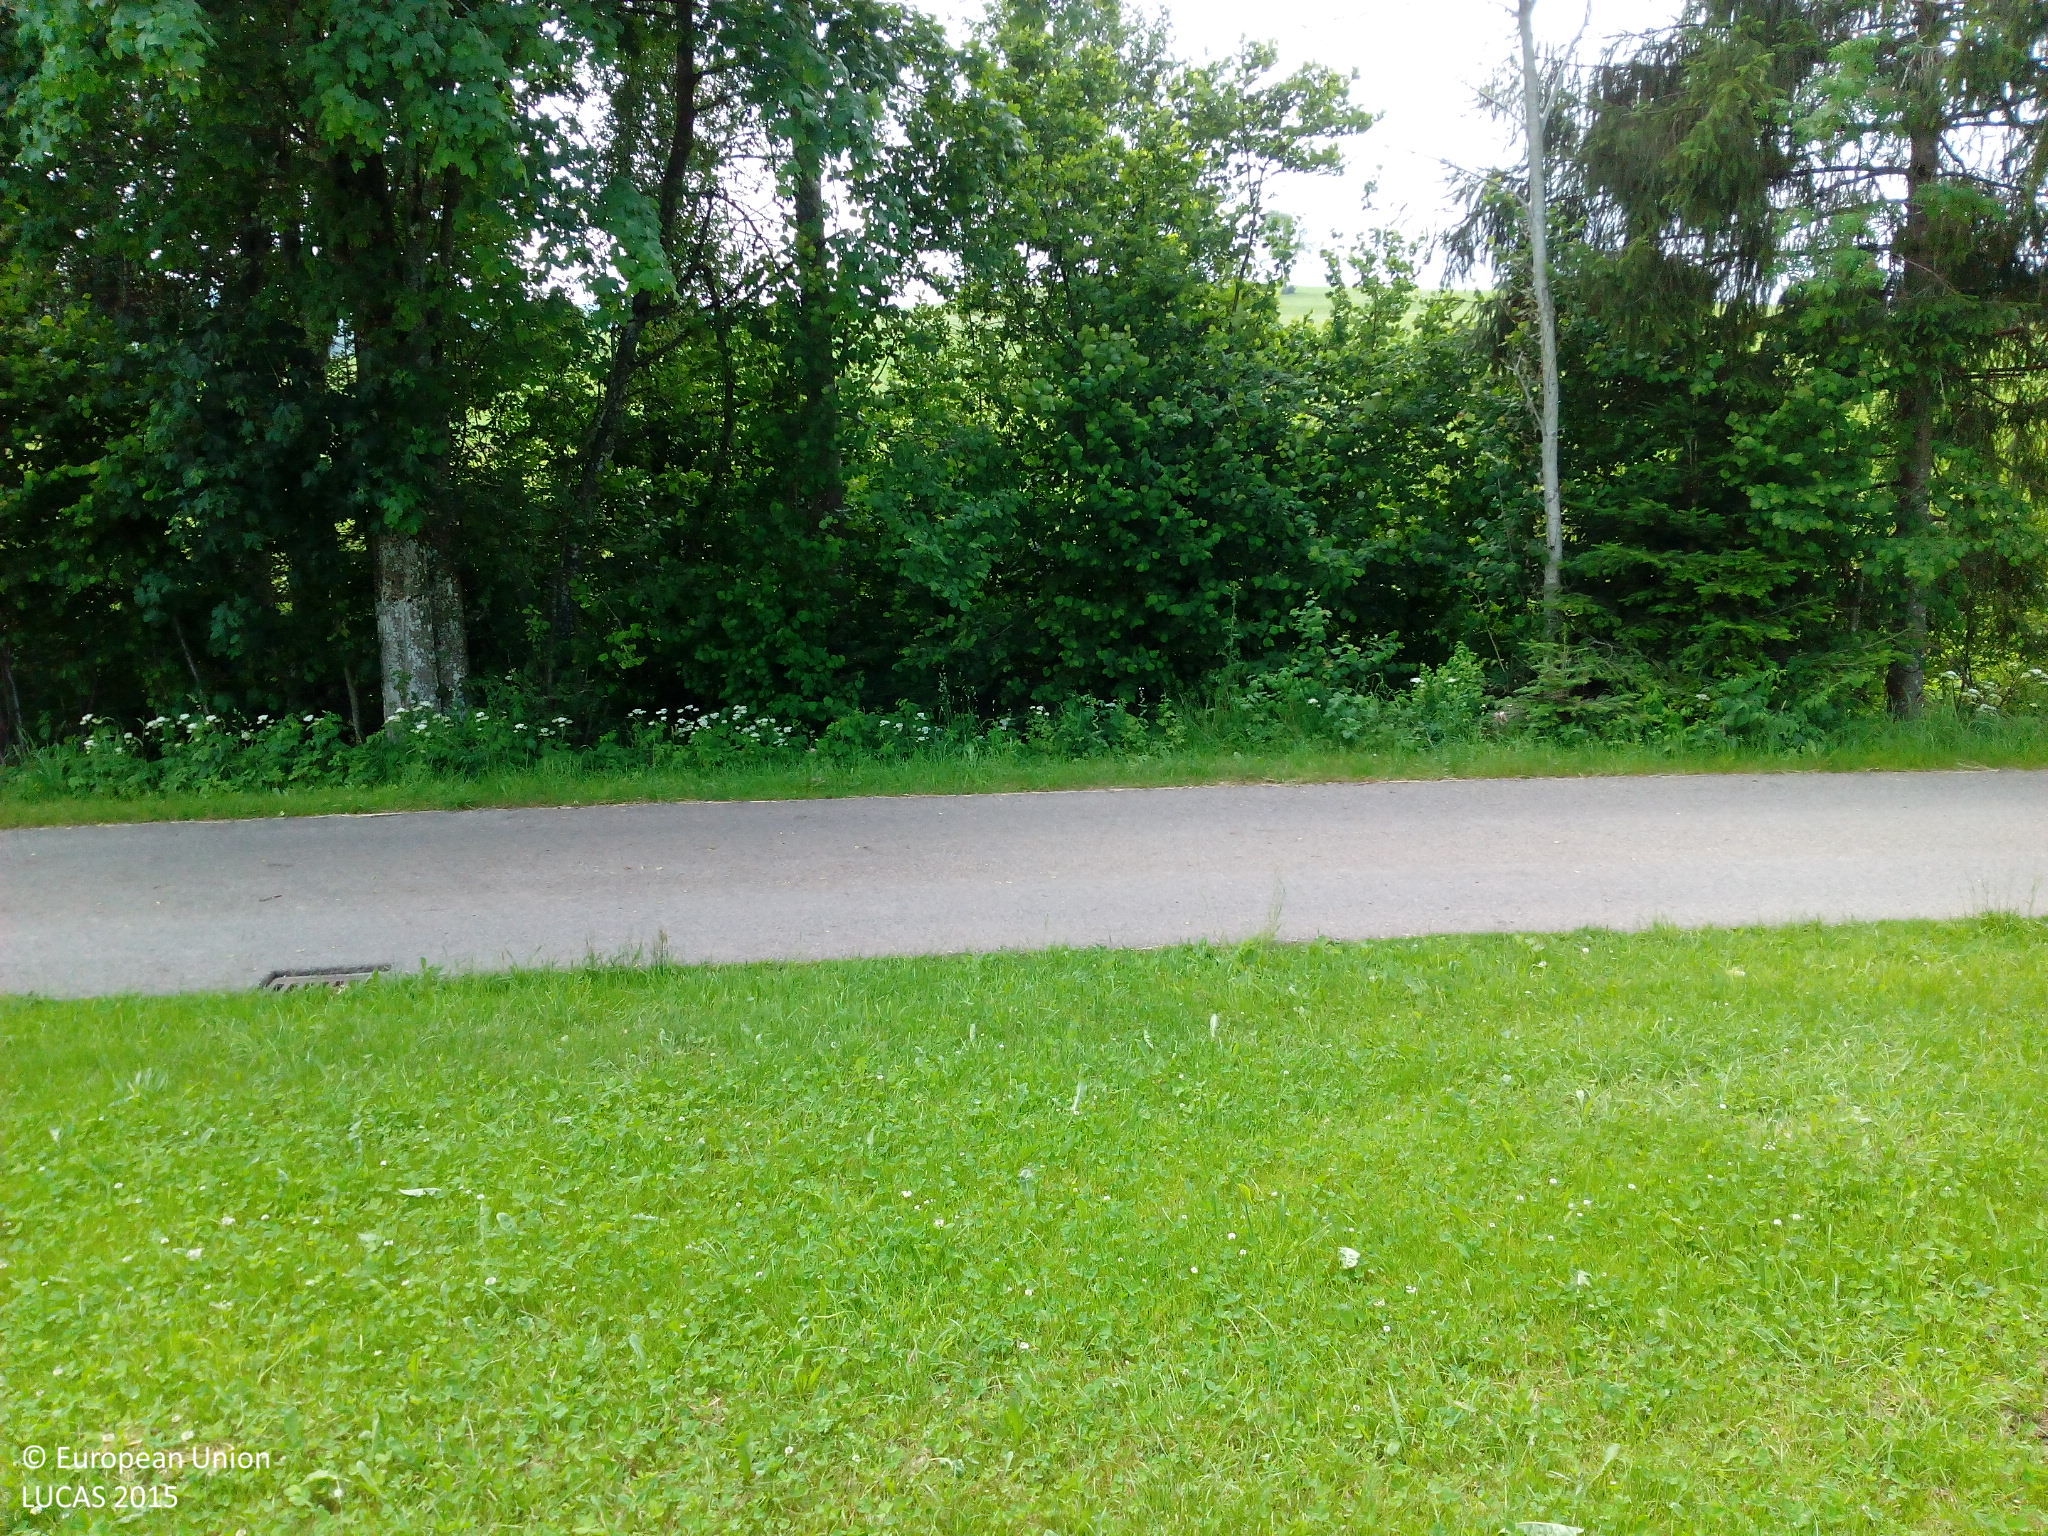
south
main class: Grassland
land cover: Grassland without tree/shrub cover
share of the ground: > 75 %
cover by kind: herbaceous plants 100 %
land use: Agriculture (excluding fallow land and kitchen gardens)
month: June
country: DE
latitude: 47.5576
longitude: 9.9336
